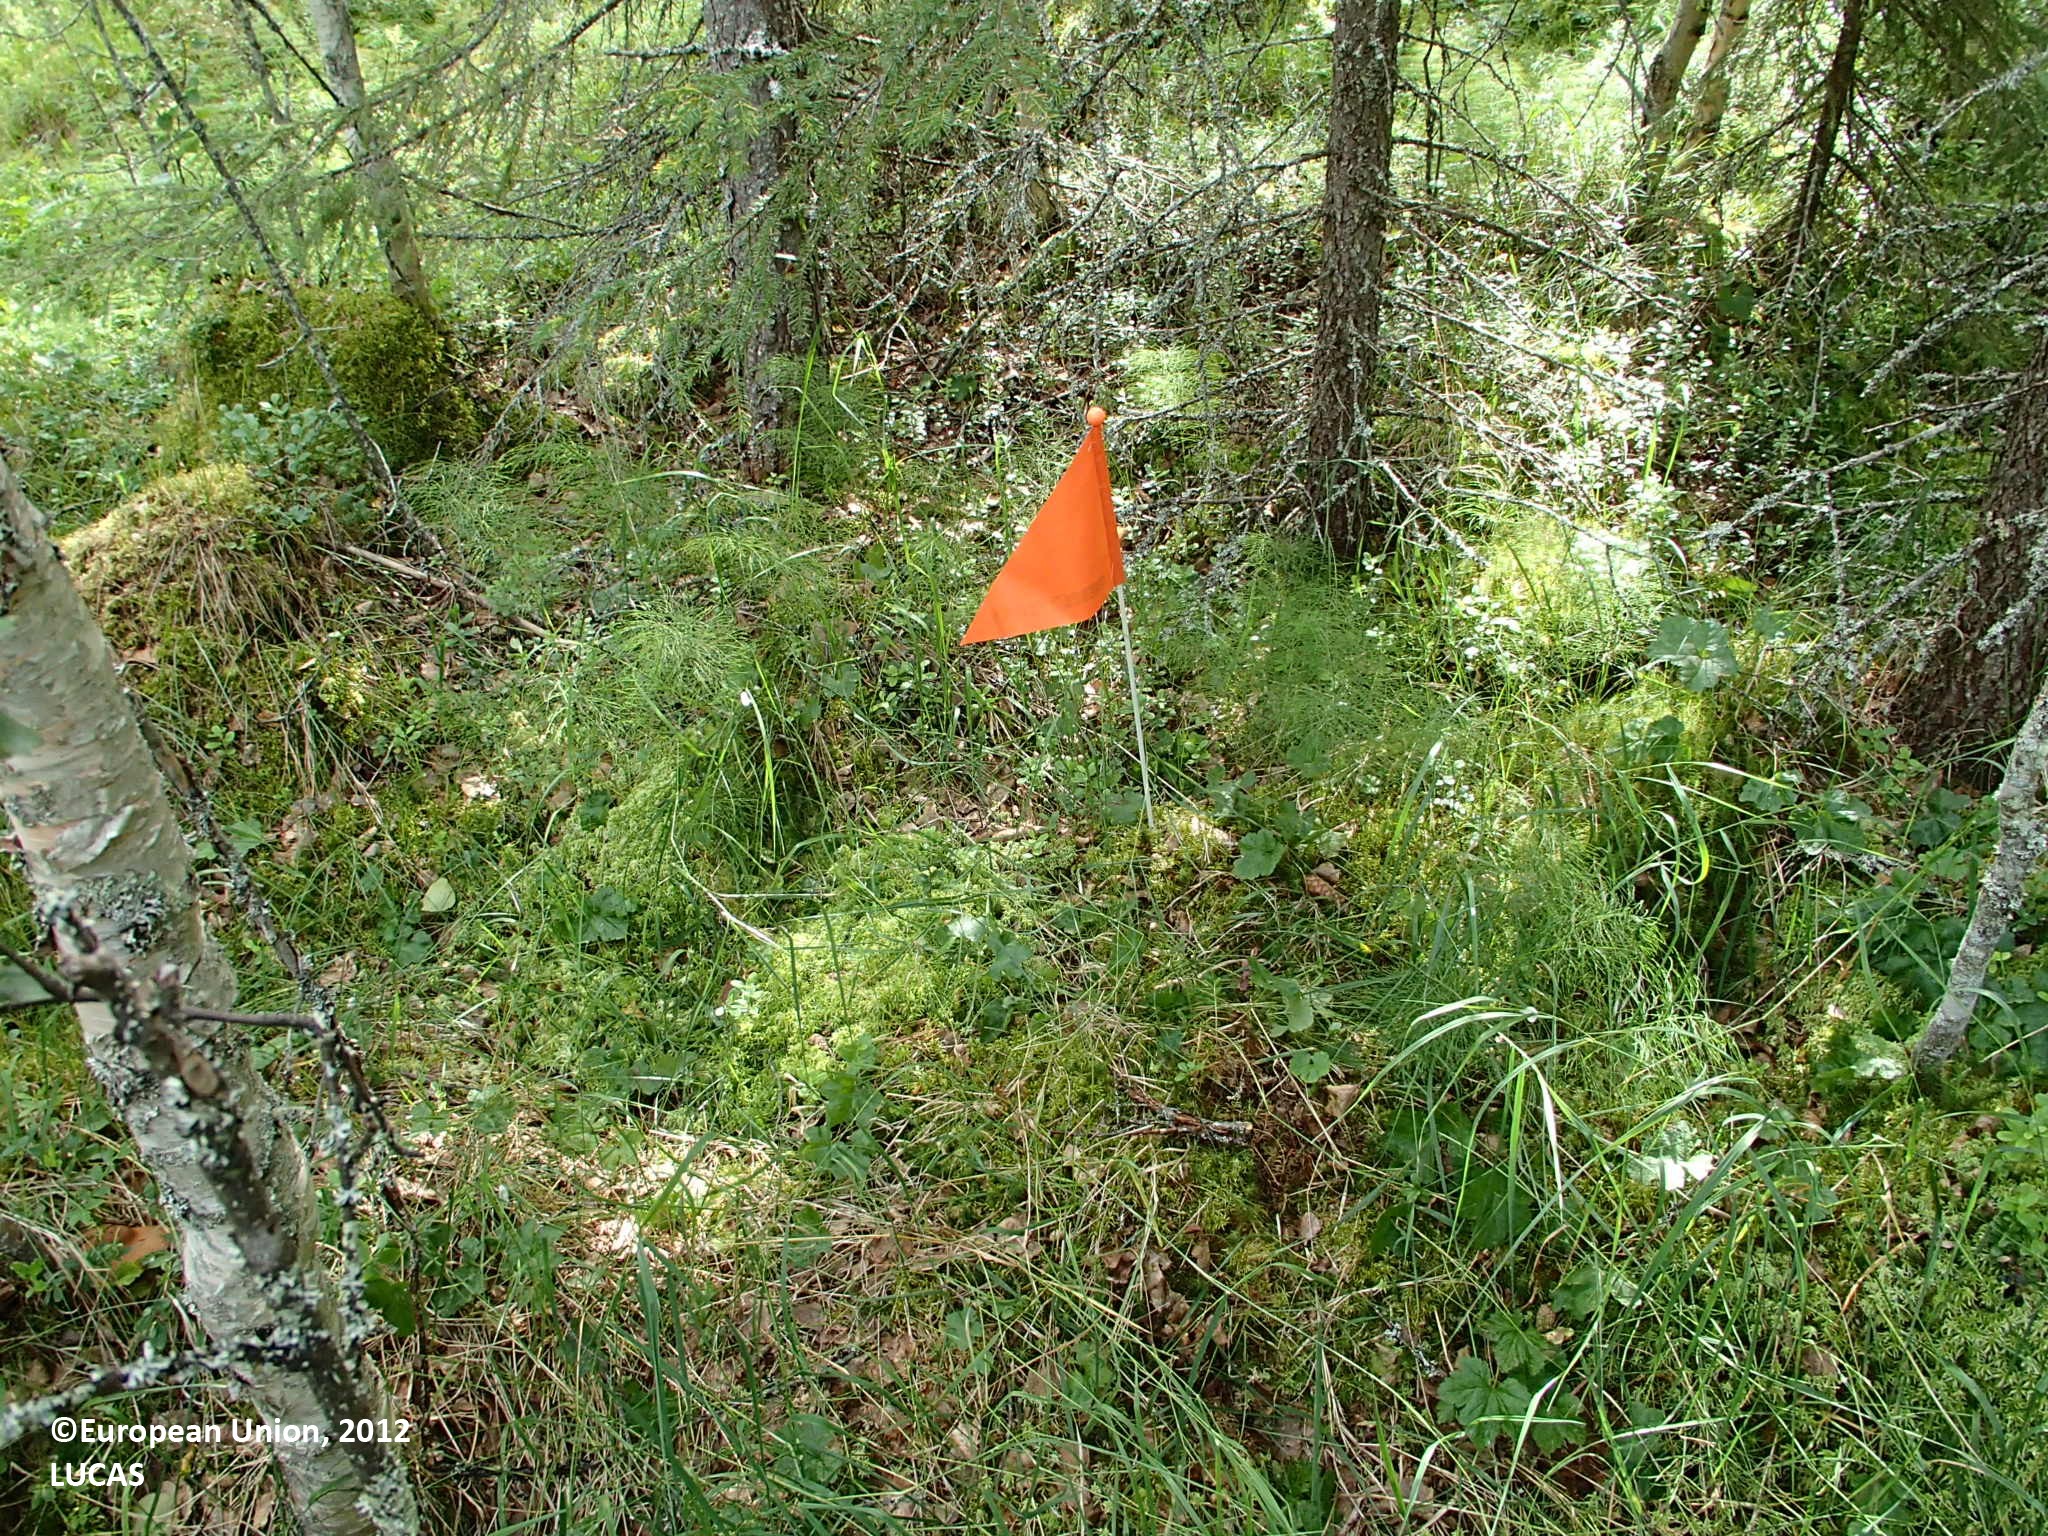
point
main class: Woodland
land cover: Other mixed woodland
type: boreal forest
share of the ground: > 75 %
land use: Forestry
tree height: > 5 m
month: July
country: FI
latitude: 66.3545
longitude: 25.4599
